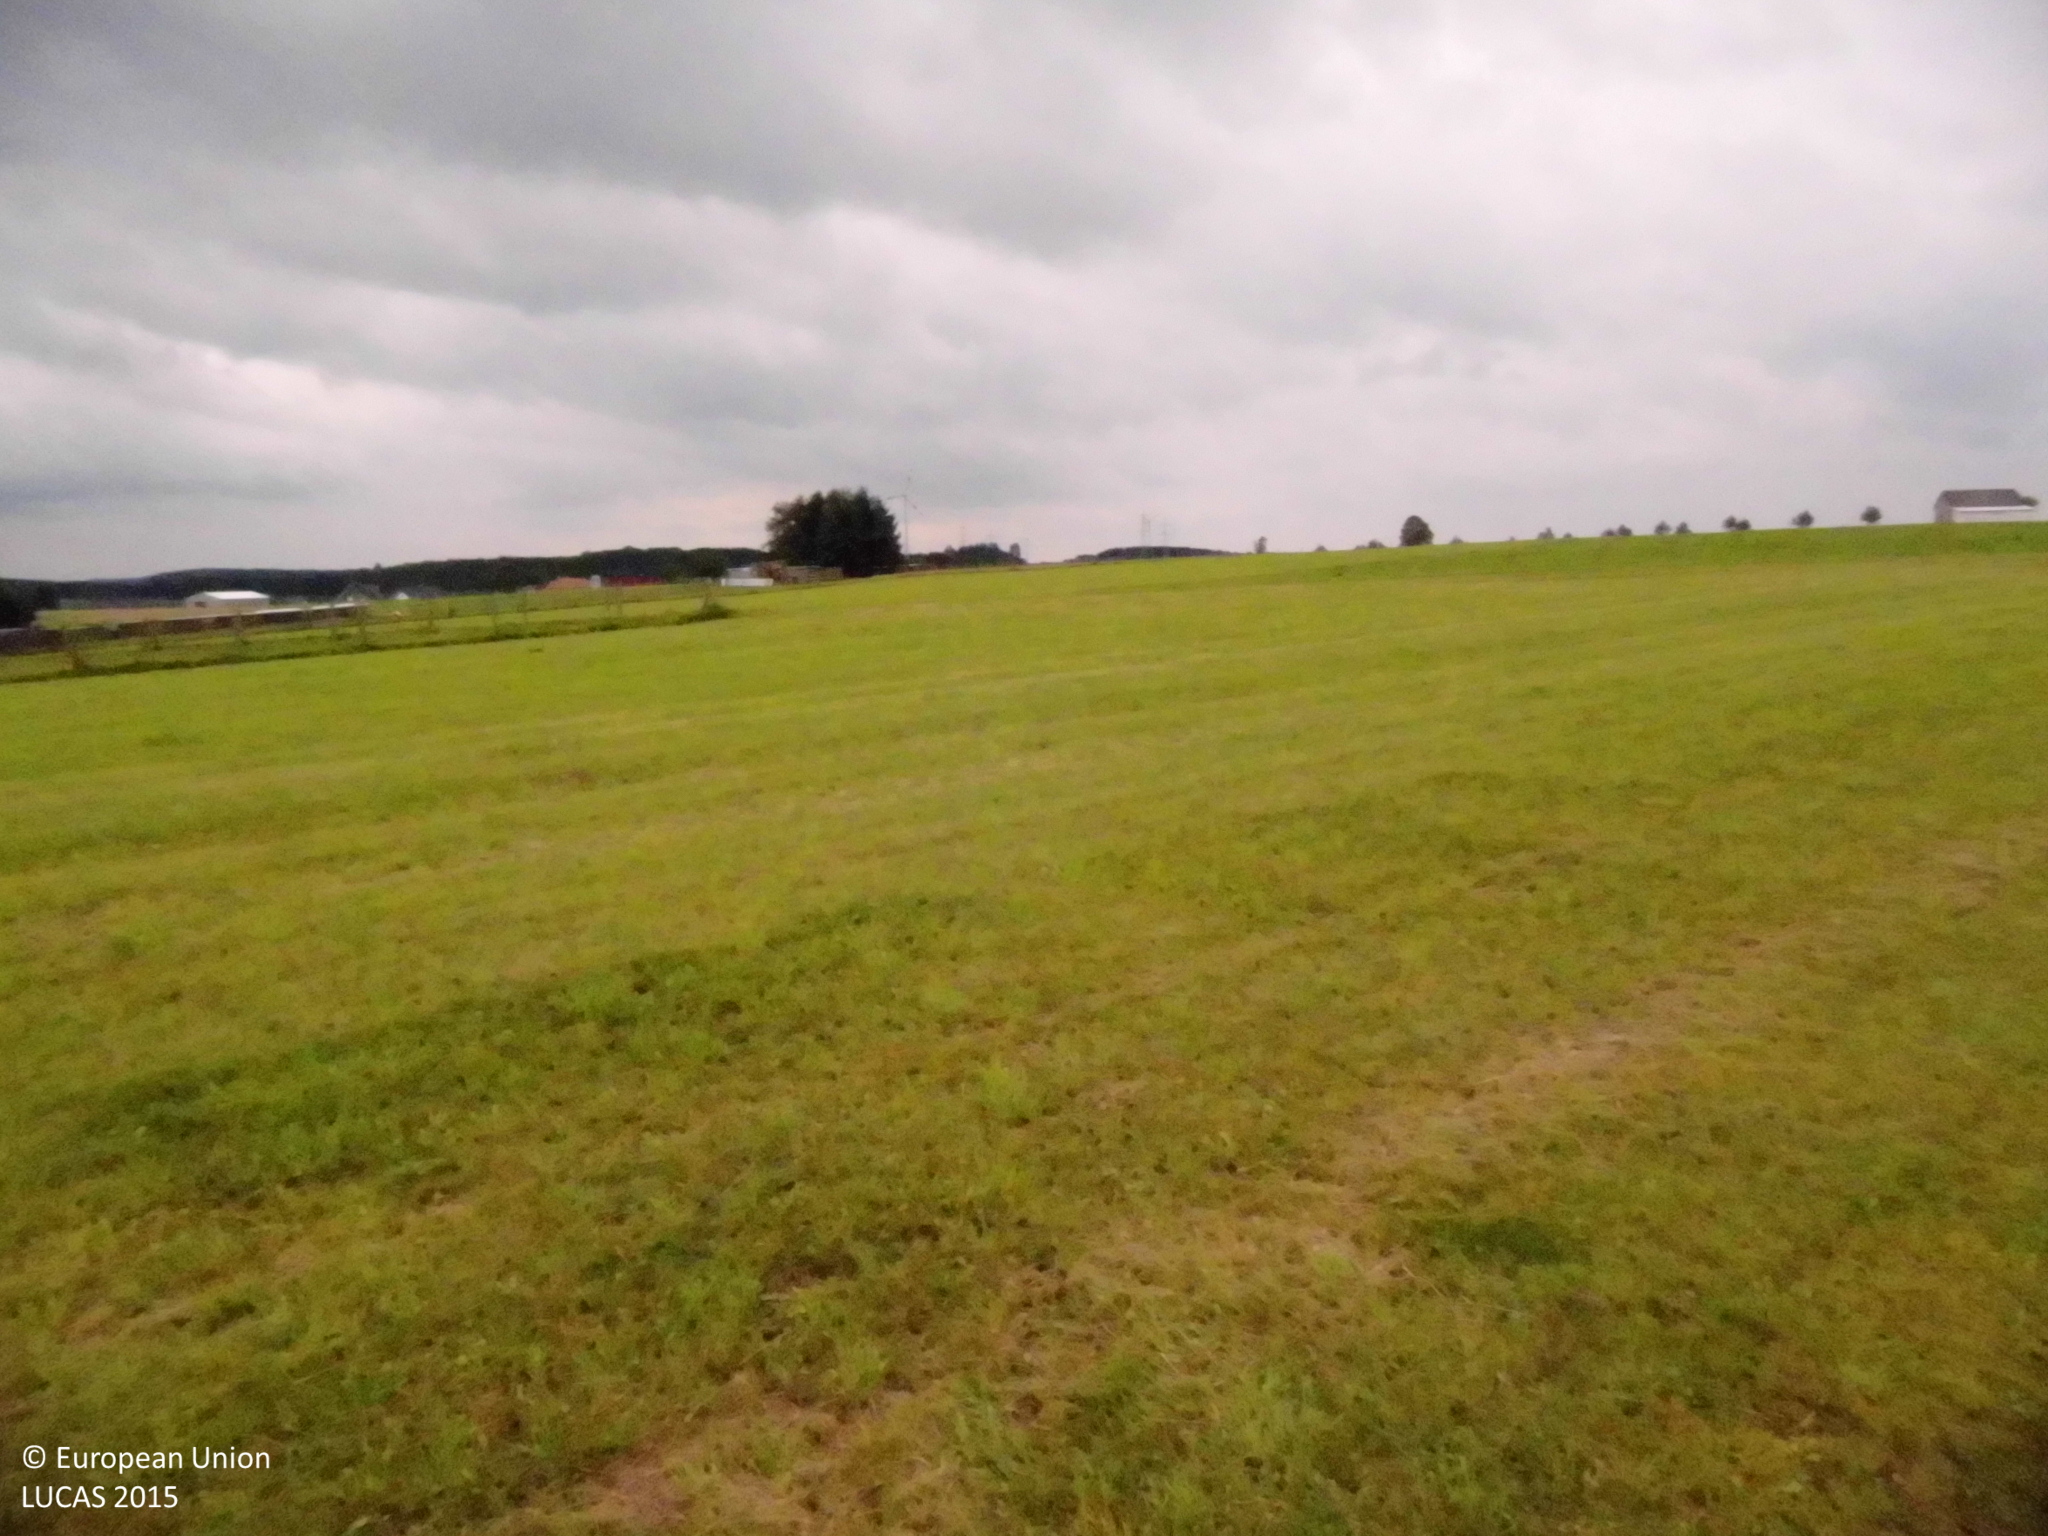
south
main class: Grassland
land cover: Grassland without tree/shrub cover
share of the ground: > 75 %
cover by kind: herbaceous plants 100 %
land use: Agriculture (excluding fallow land and kitchen gardens)
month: August
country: DE
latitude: 50.6704
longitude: 8.0053
